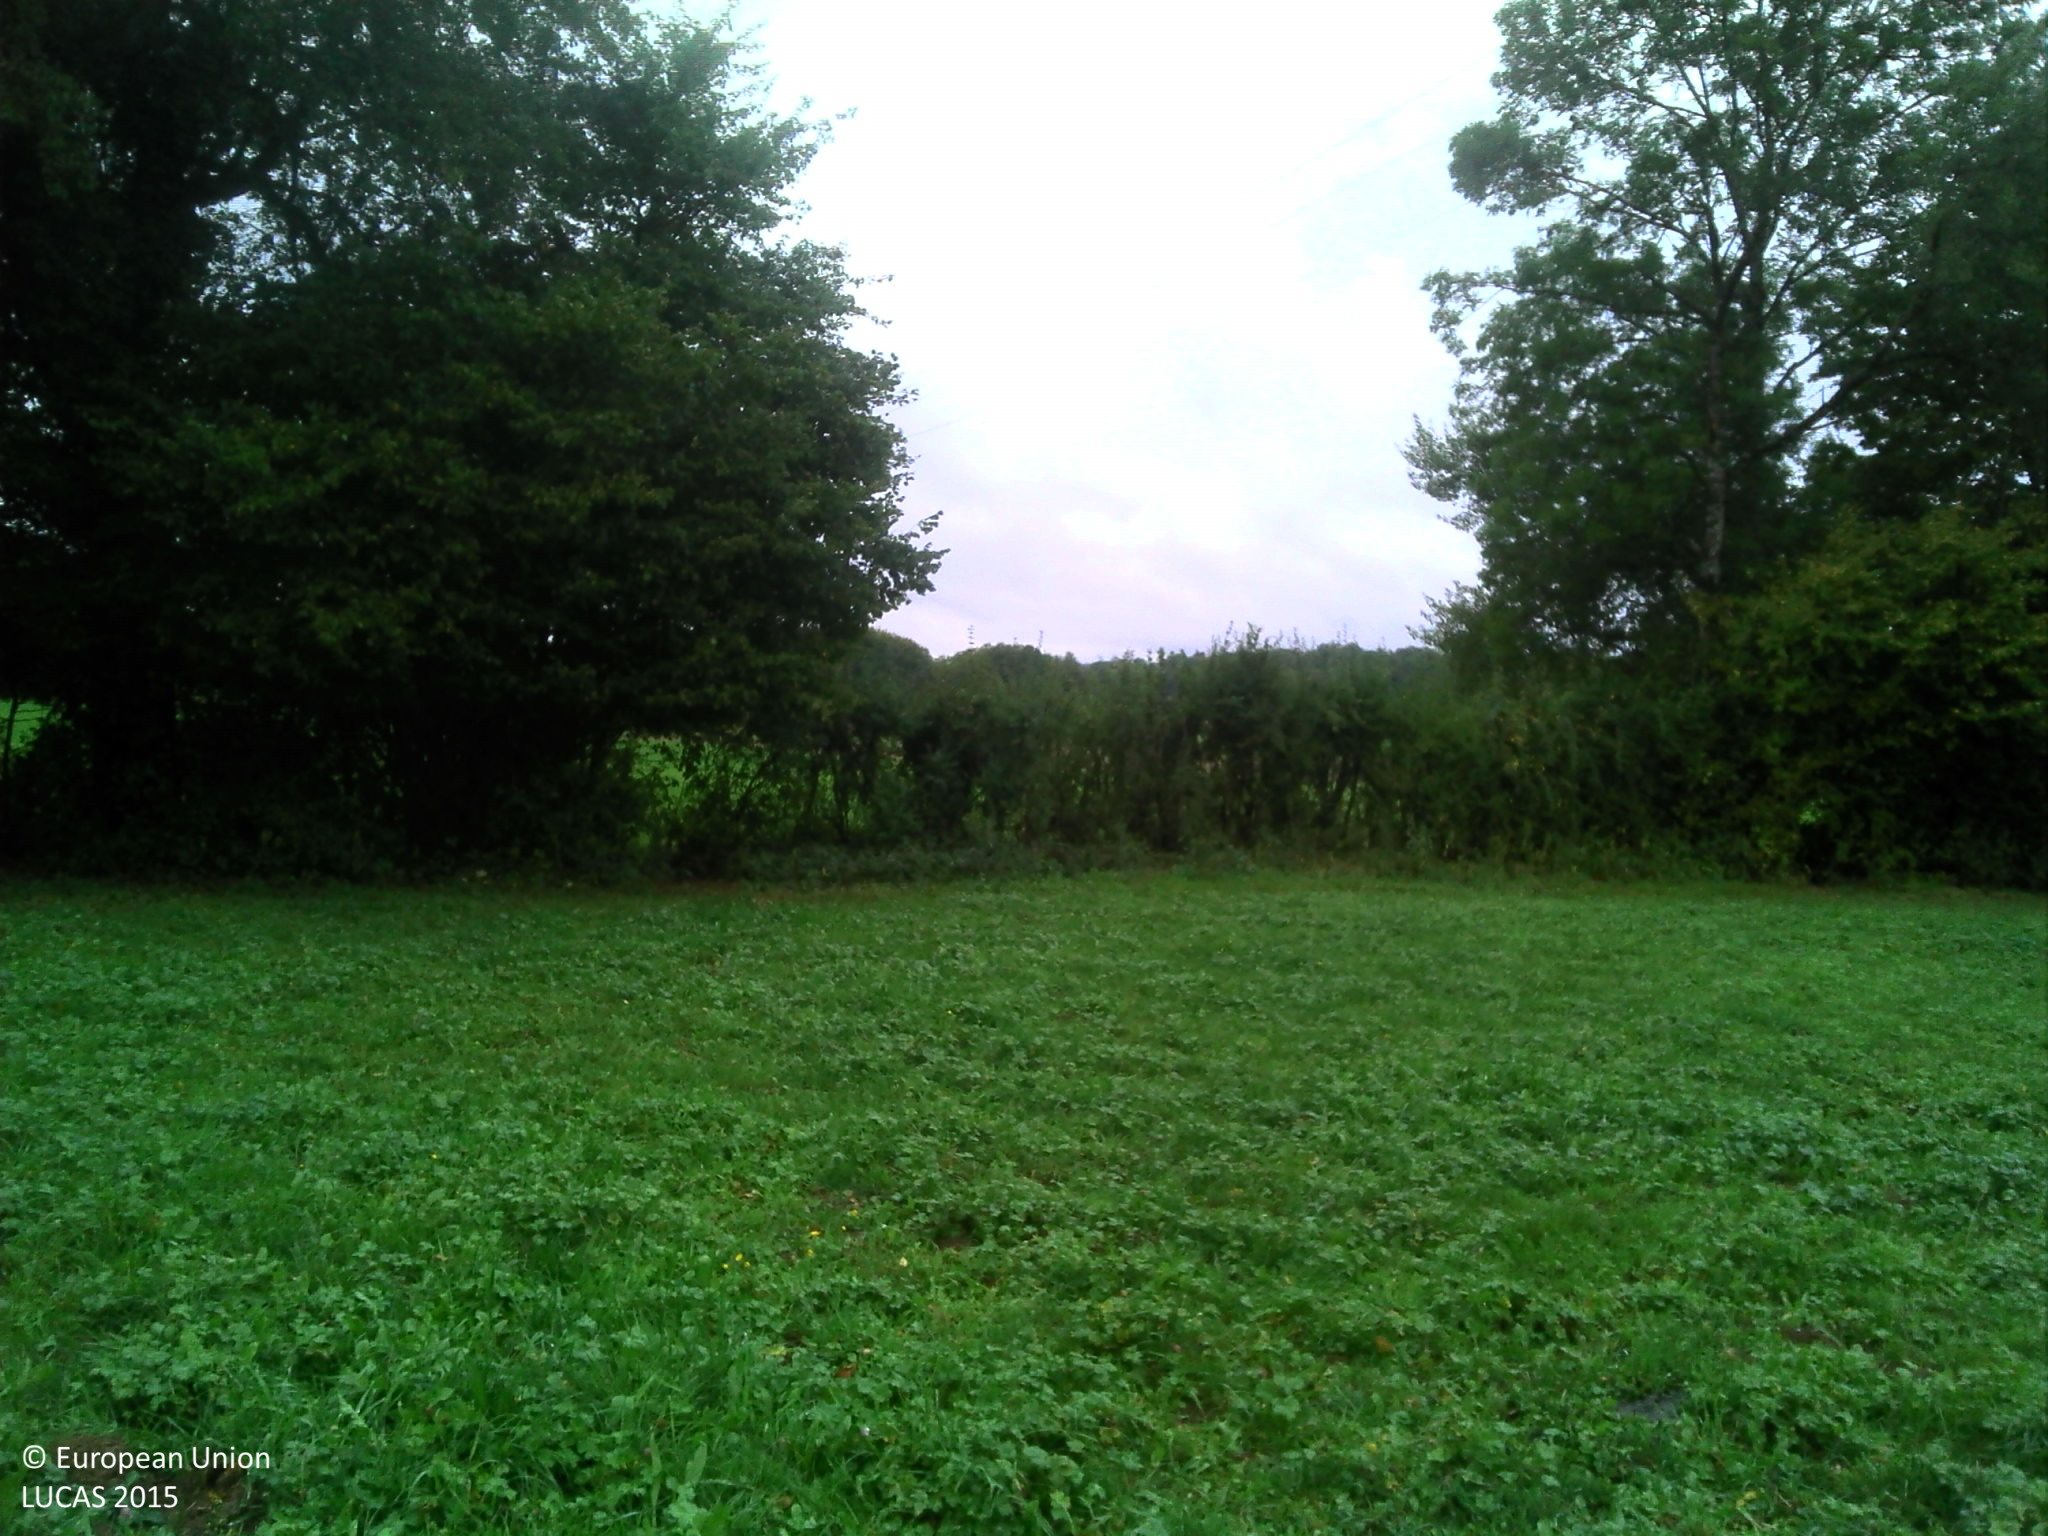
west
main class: Grassland
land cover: Grassland without tree/shrub cover
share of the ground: > 75 %
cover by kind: herbaceous plants 95 %, unconsolidated bare surface 5 %
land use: Agriculture (excluding fallow land and kitchen gardens)
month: September
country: FR
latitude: 47.1505
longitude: 6.2434
